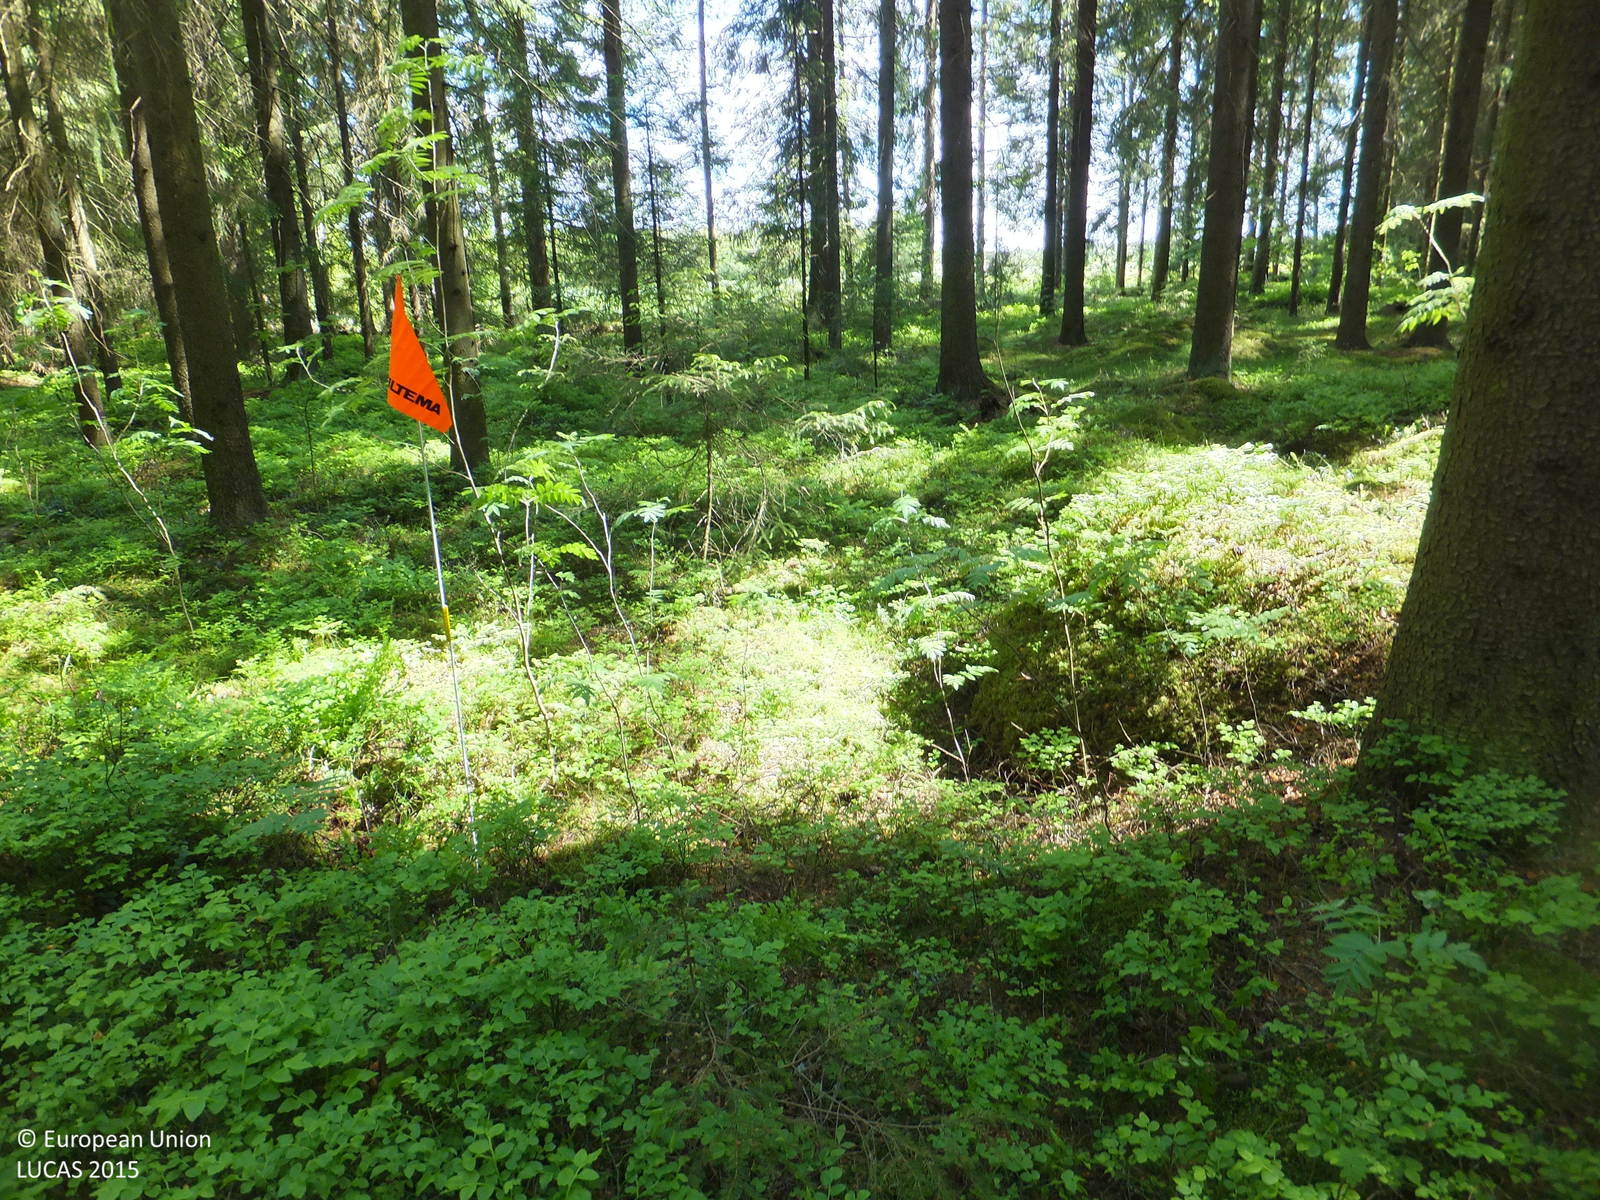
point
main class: Woodland
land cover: Spruce dominated coniferous woodland
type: boreal forest
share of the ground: > 75 %
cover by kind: coniferous forest trees 95 %, shrubs 5 %
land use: Forestry
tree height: > 5 m
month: June
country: FI
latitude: 63.3458
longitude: 22.5772
